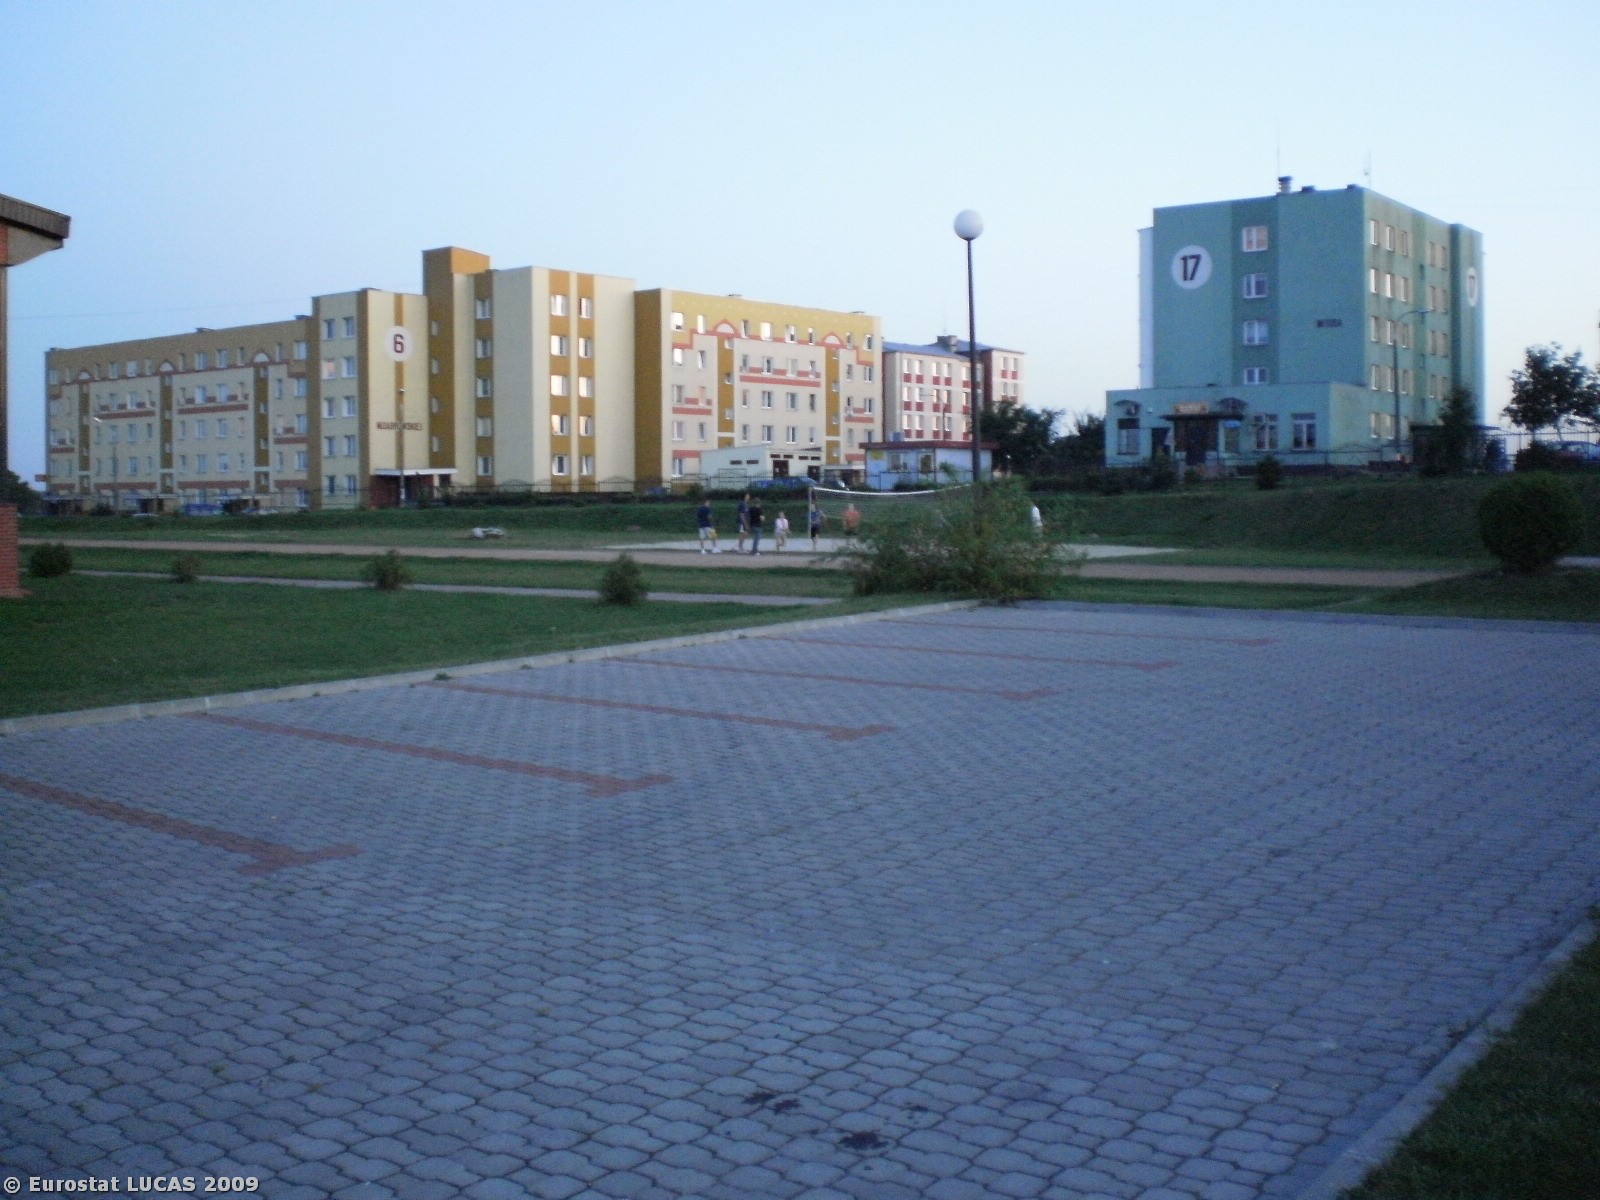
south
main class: Grassland
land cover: Grassland with sparse tree/shrub cover
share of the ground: > 75 %
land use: Commerce, finance, business
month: August
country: PL
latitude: 53.4101
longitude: 21.9258
